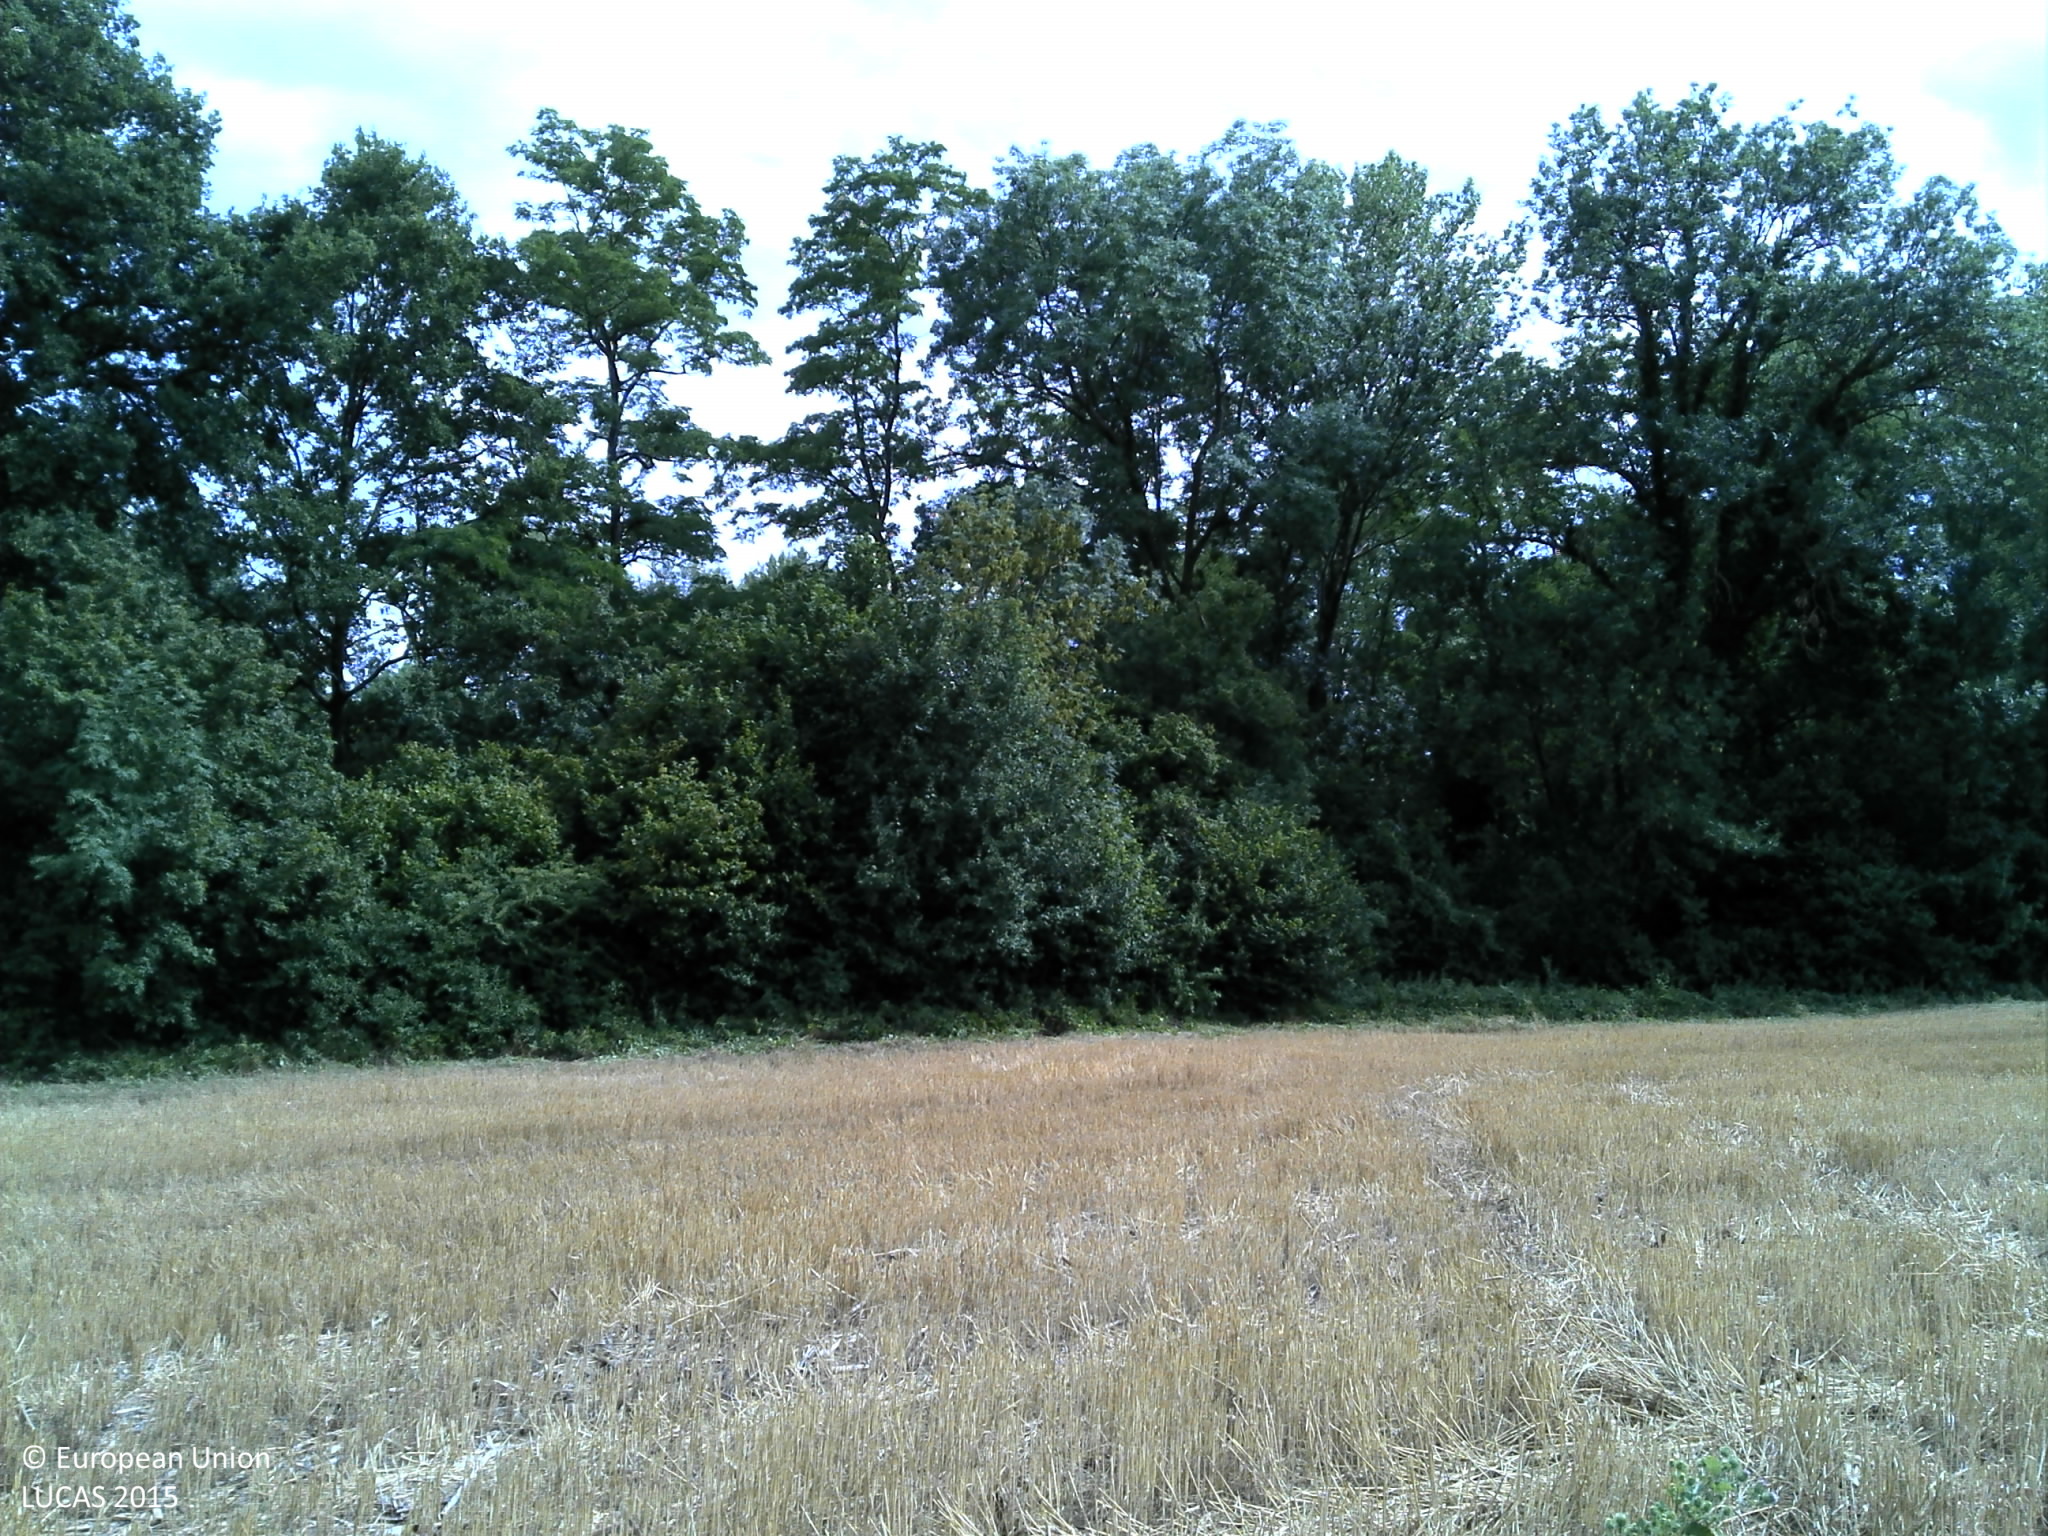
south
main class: Cropland
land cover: Common wheat
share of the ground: > 75 %
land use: Agriculture (excluding fallow land and kitchen gardens)
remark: Harvested field
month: July
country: FR
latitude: 45.7094
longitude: 3.3339
